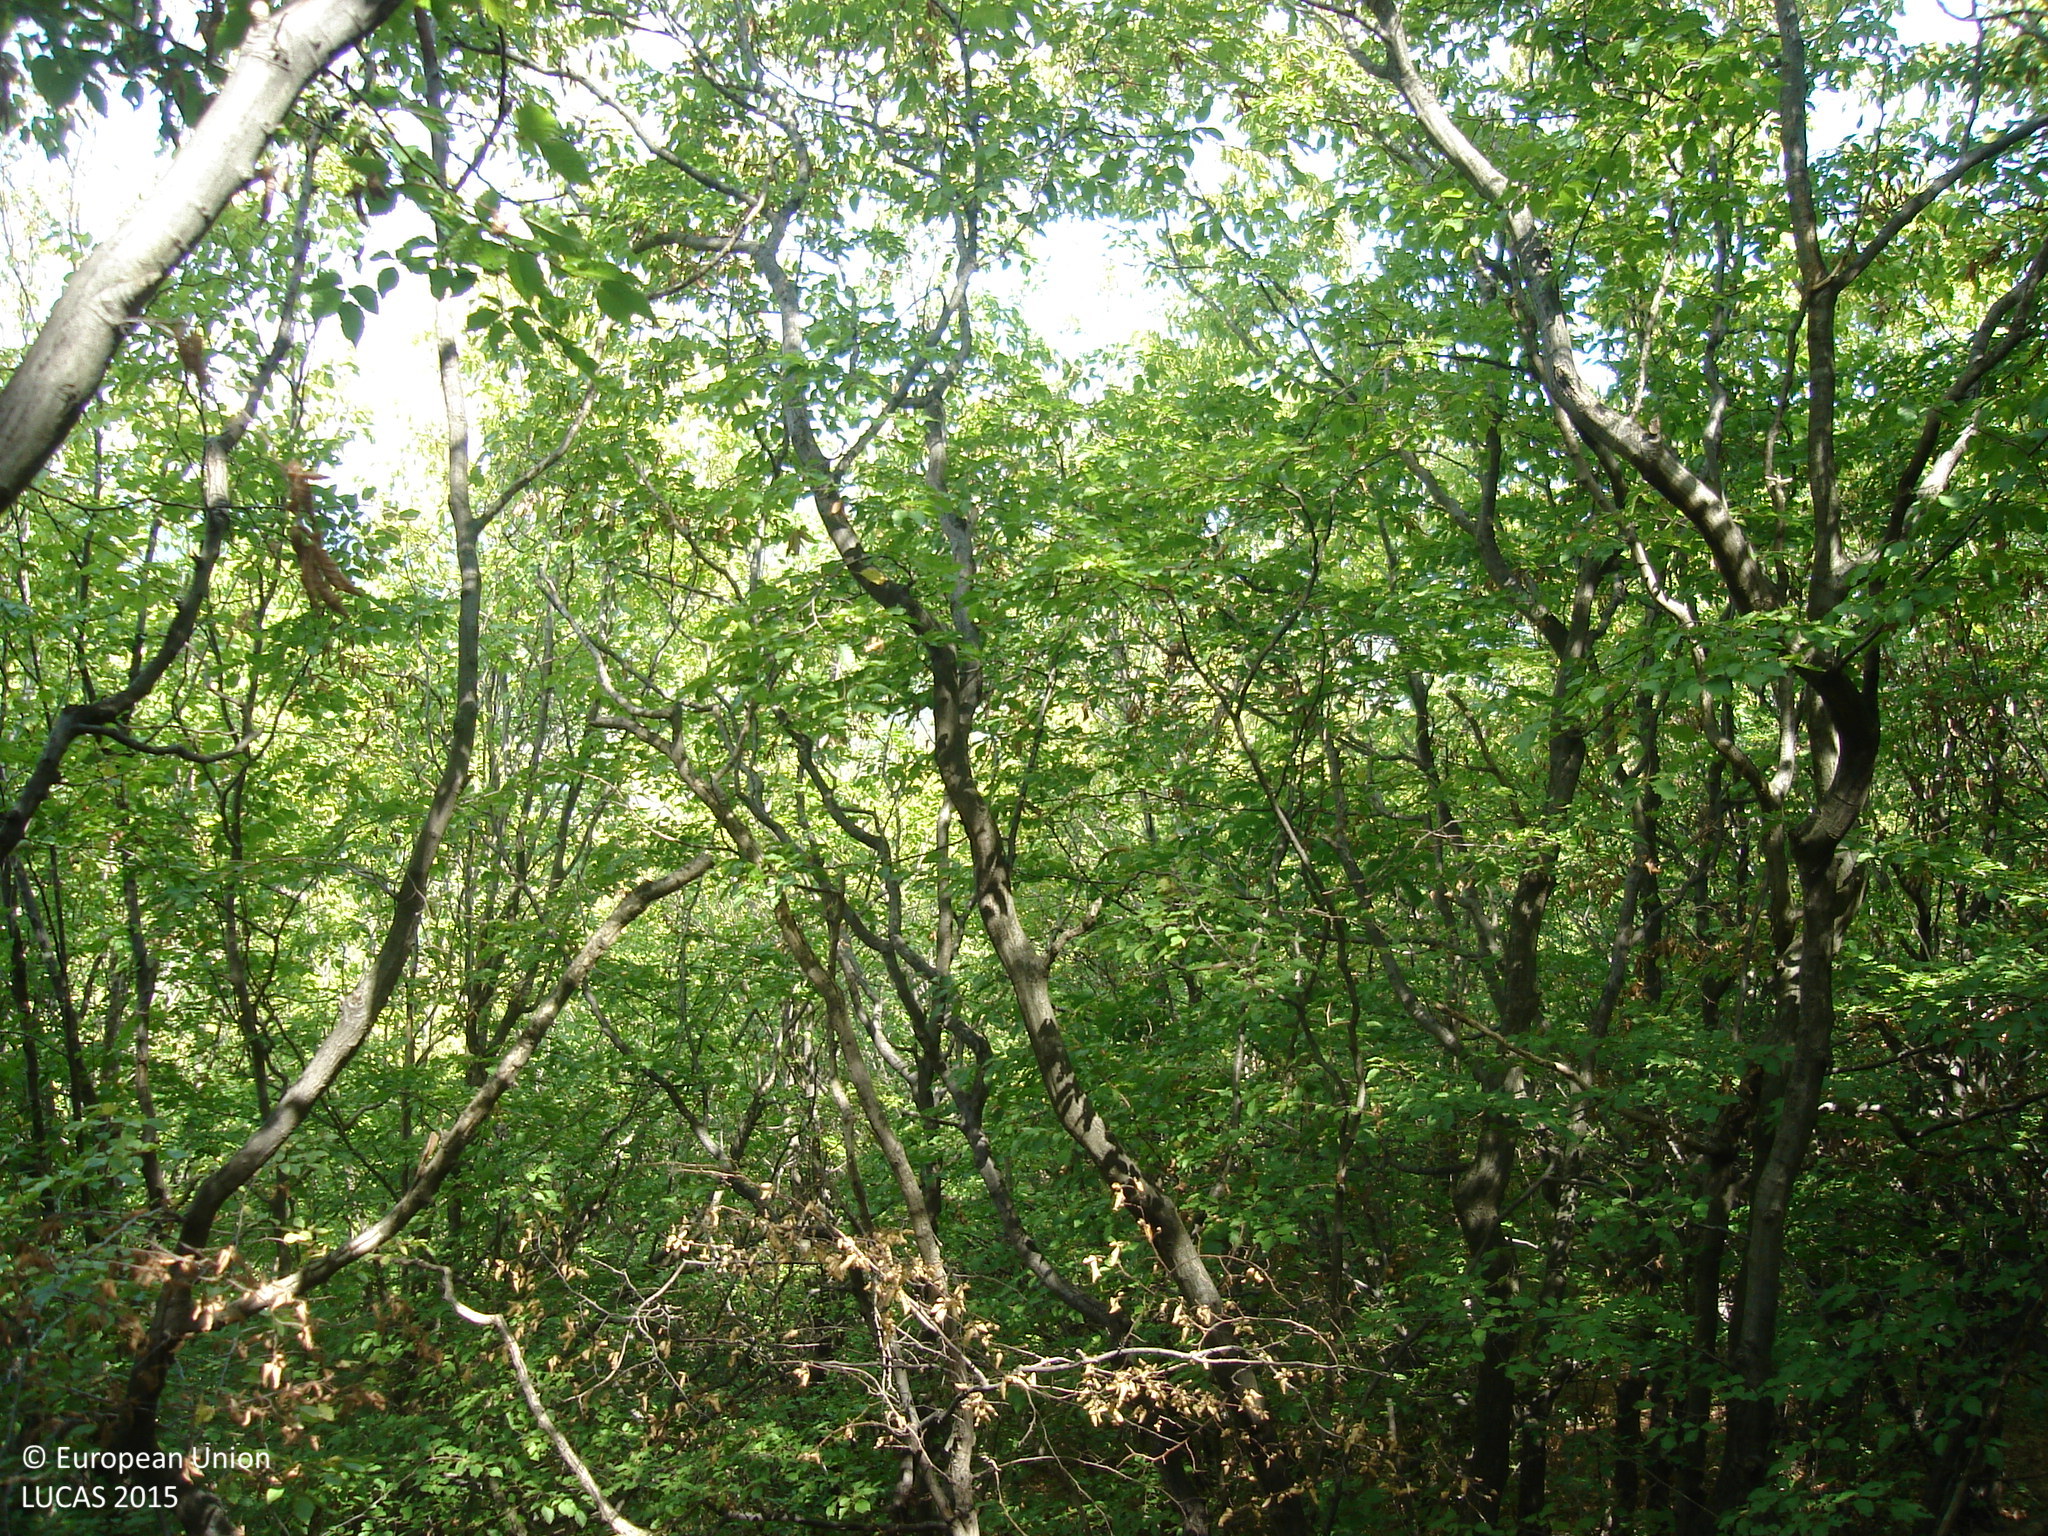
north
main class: Woodland
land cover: Broadleaved woodland
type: beech forest
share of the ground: > 75 %
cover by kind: broadleaved forest trees 85 %, consolidated bare surface 15 %
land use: Forestry
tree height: > 5 m
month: September
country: BG
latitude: 42.6371
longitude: 23.9333
